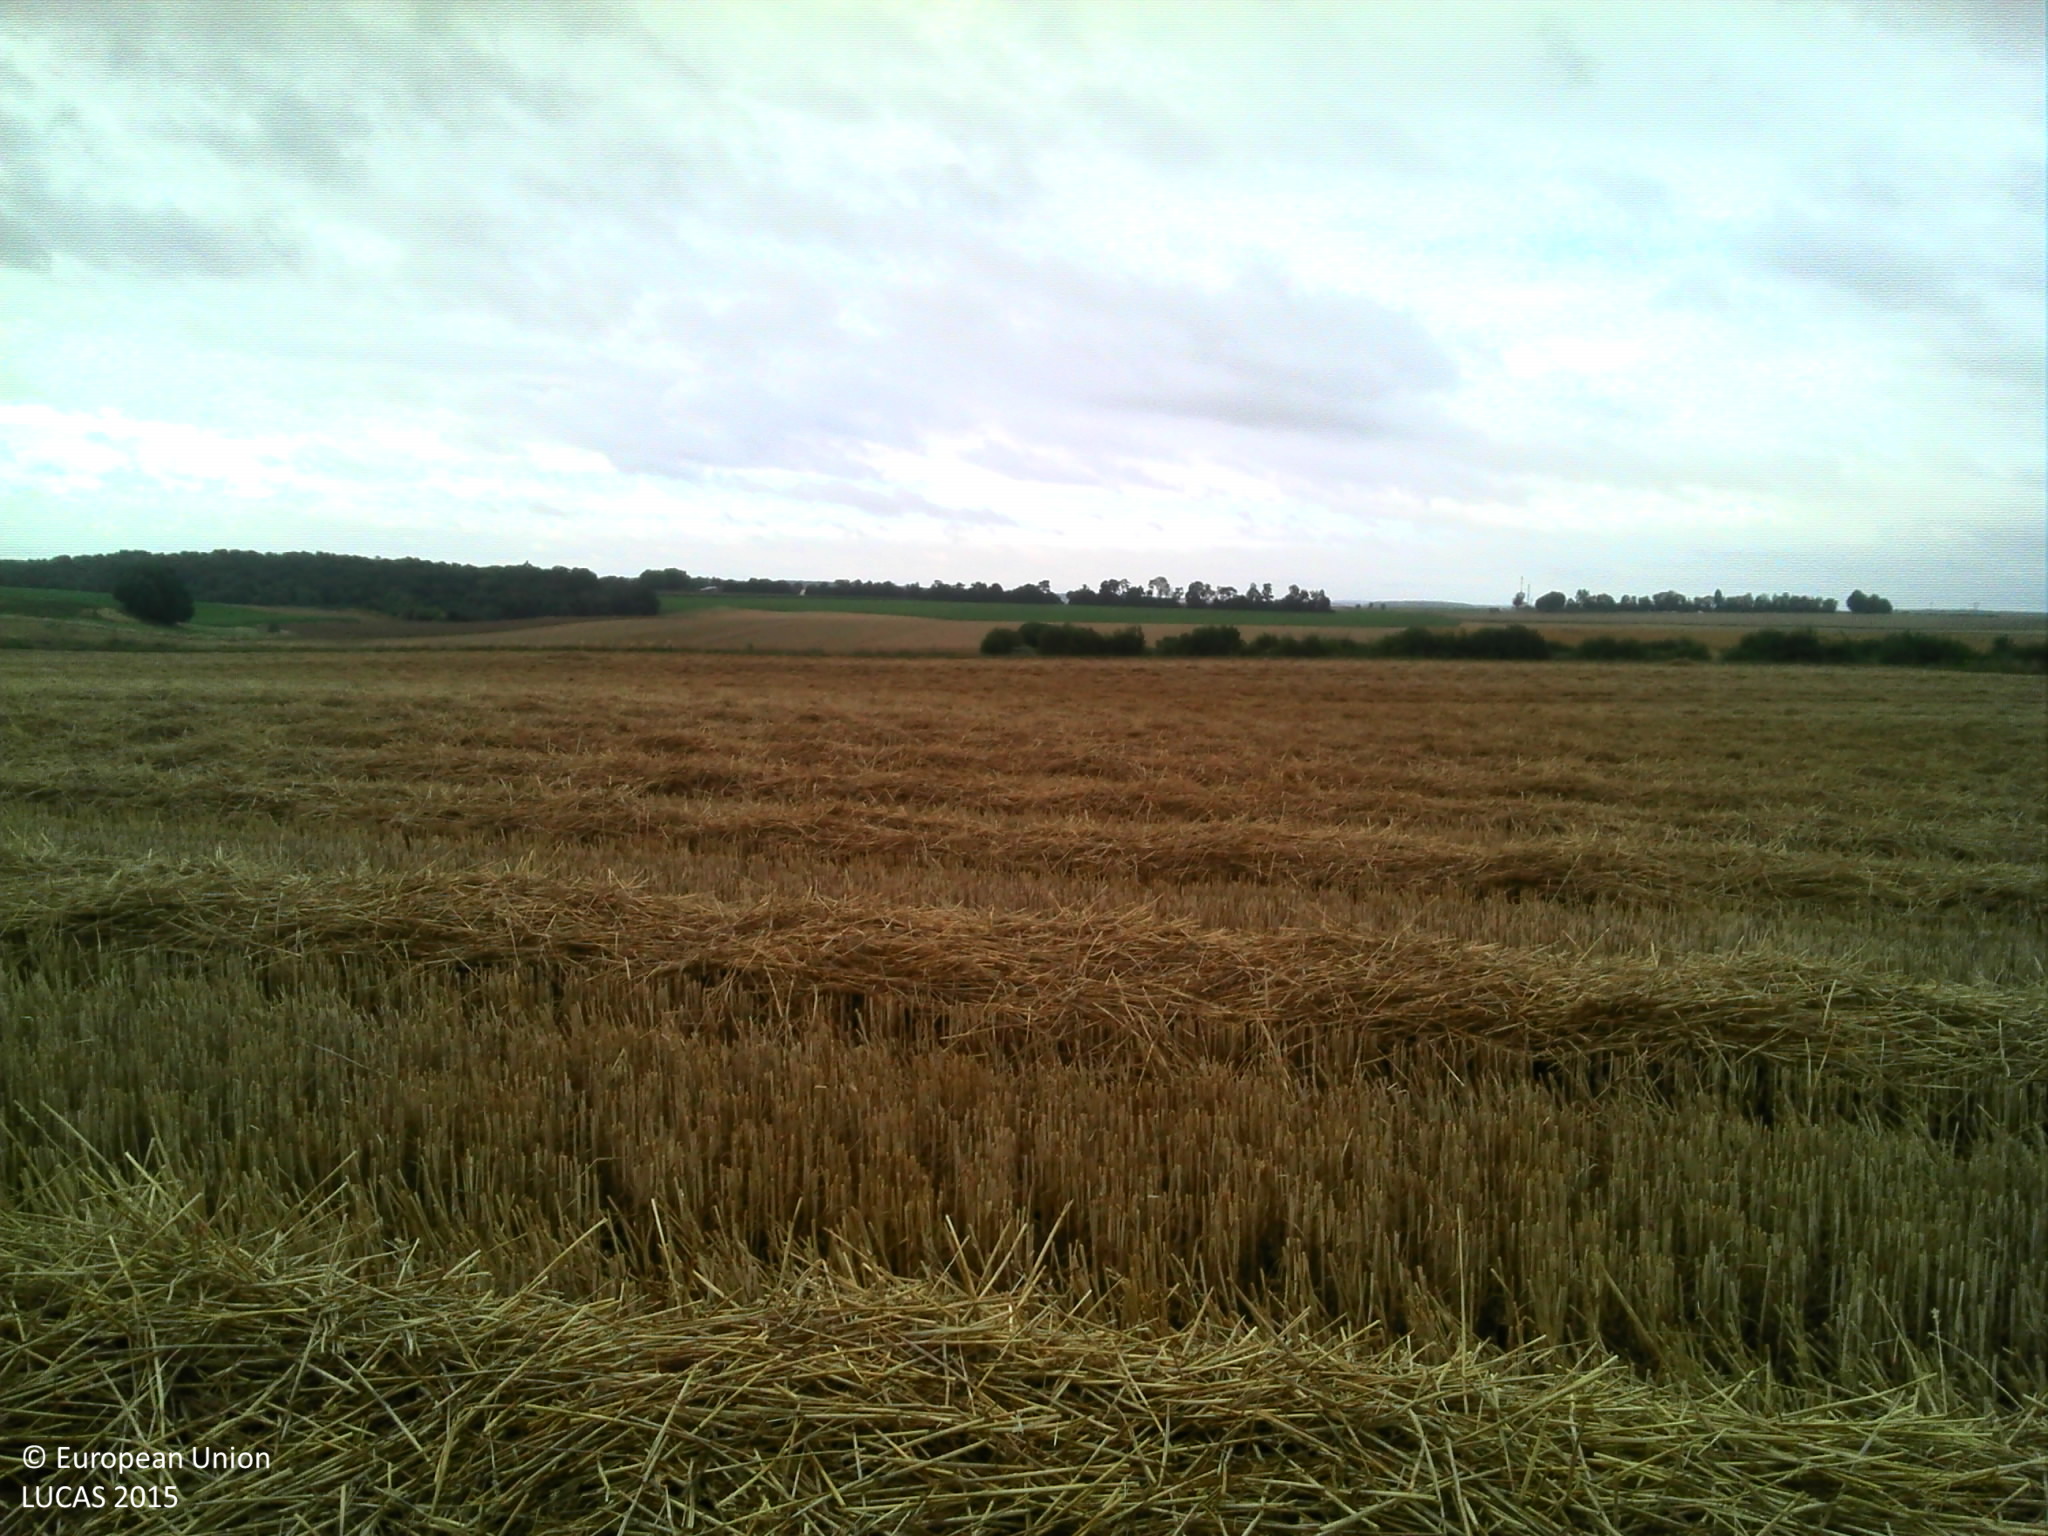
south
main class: Cropland
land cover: Common wheat
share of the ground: > 75 %
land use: Agriculture (excluding fallow land and kitchen gardens)
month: July
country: FR
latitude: 49.8444
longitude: 2.4643
